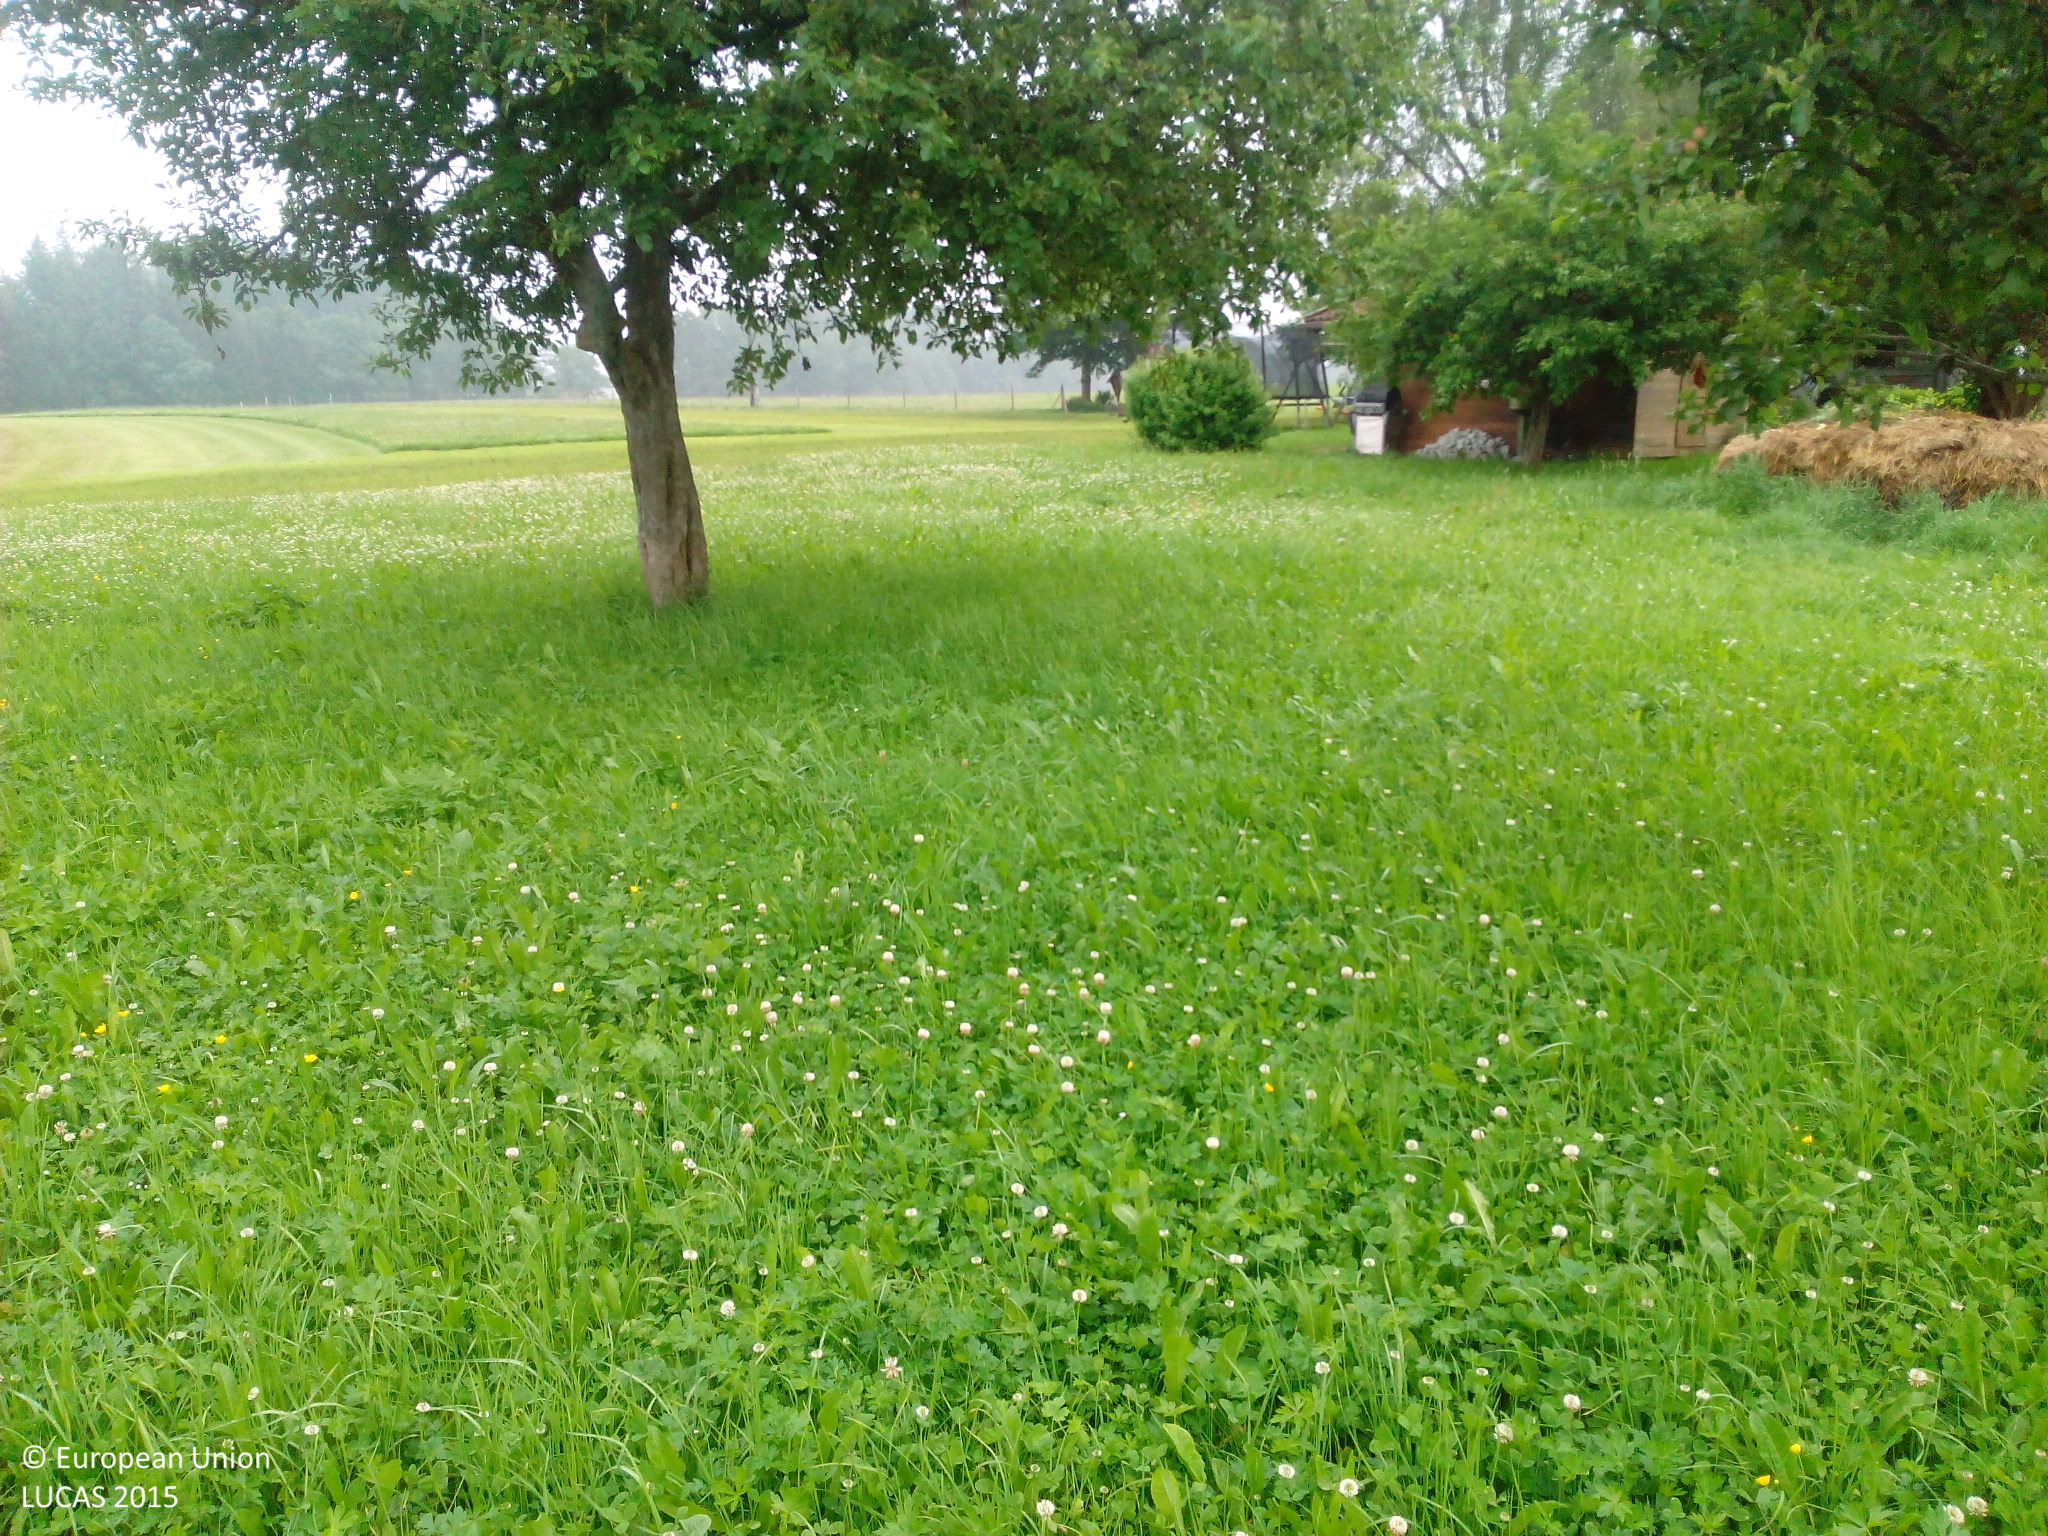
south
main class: Grassland
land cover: Grassland with sparse tree/shrub cover
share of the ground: > 75 %
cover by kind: herbaceous plants 95 %, broadleaved forest trees 5 %
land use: Agriculture (excluding fallow land and kitchen gardens)
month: June
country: DE
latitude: 47.7373
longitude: 10.2532
